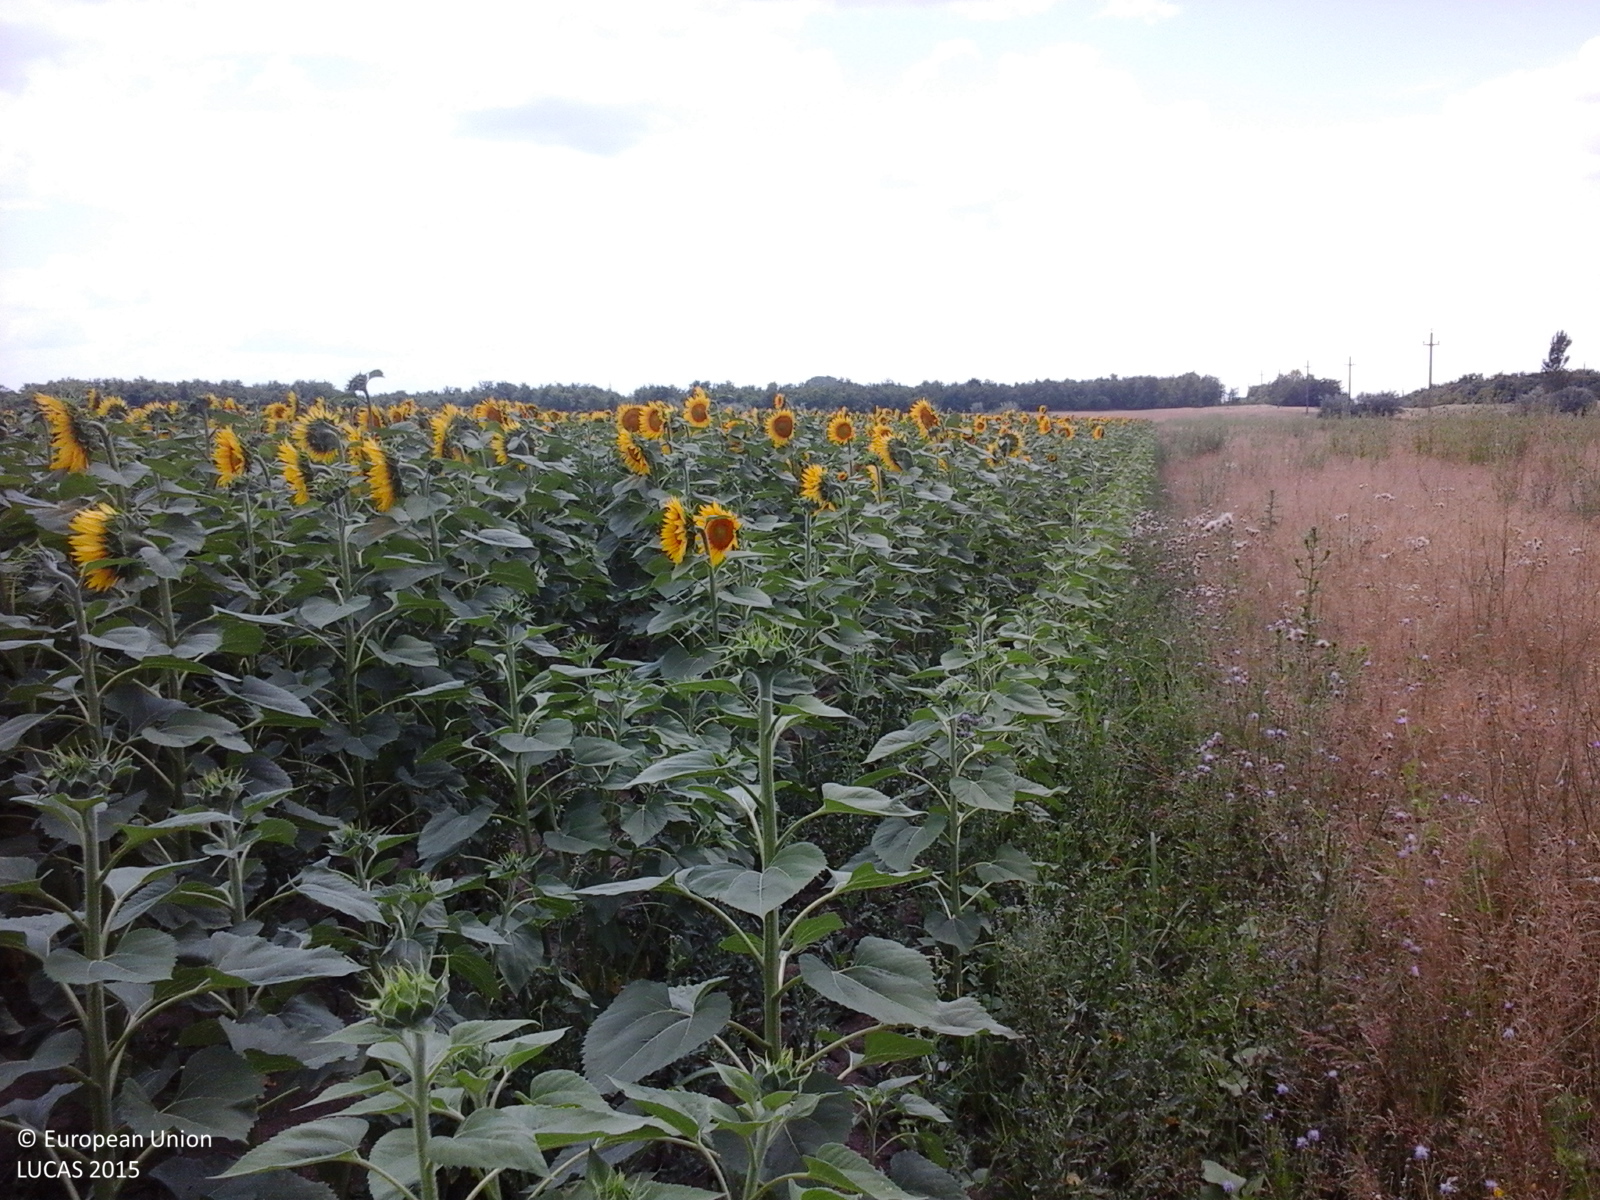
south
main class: Cropland
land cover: Sunflower
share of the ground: > 75 %
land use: Agriculture (excluding fallow land and kitchen gardens)
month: July
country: RO
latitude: 43.8959
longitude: 24.0882
